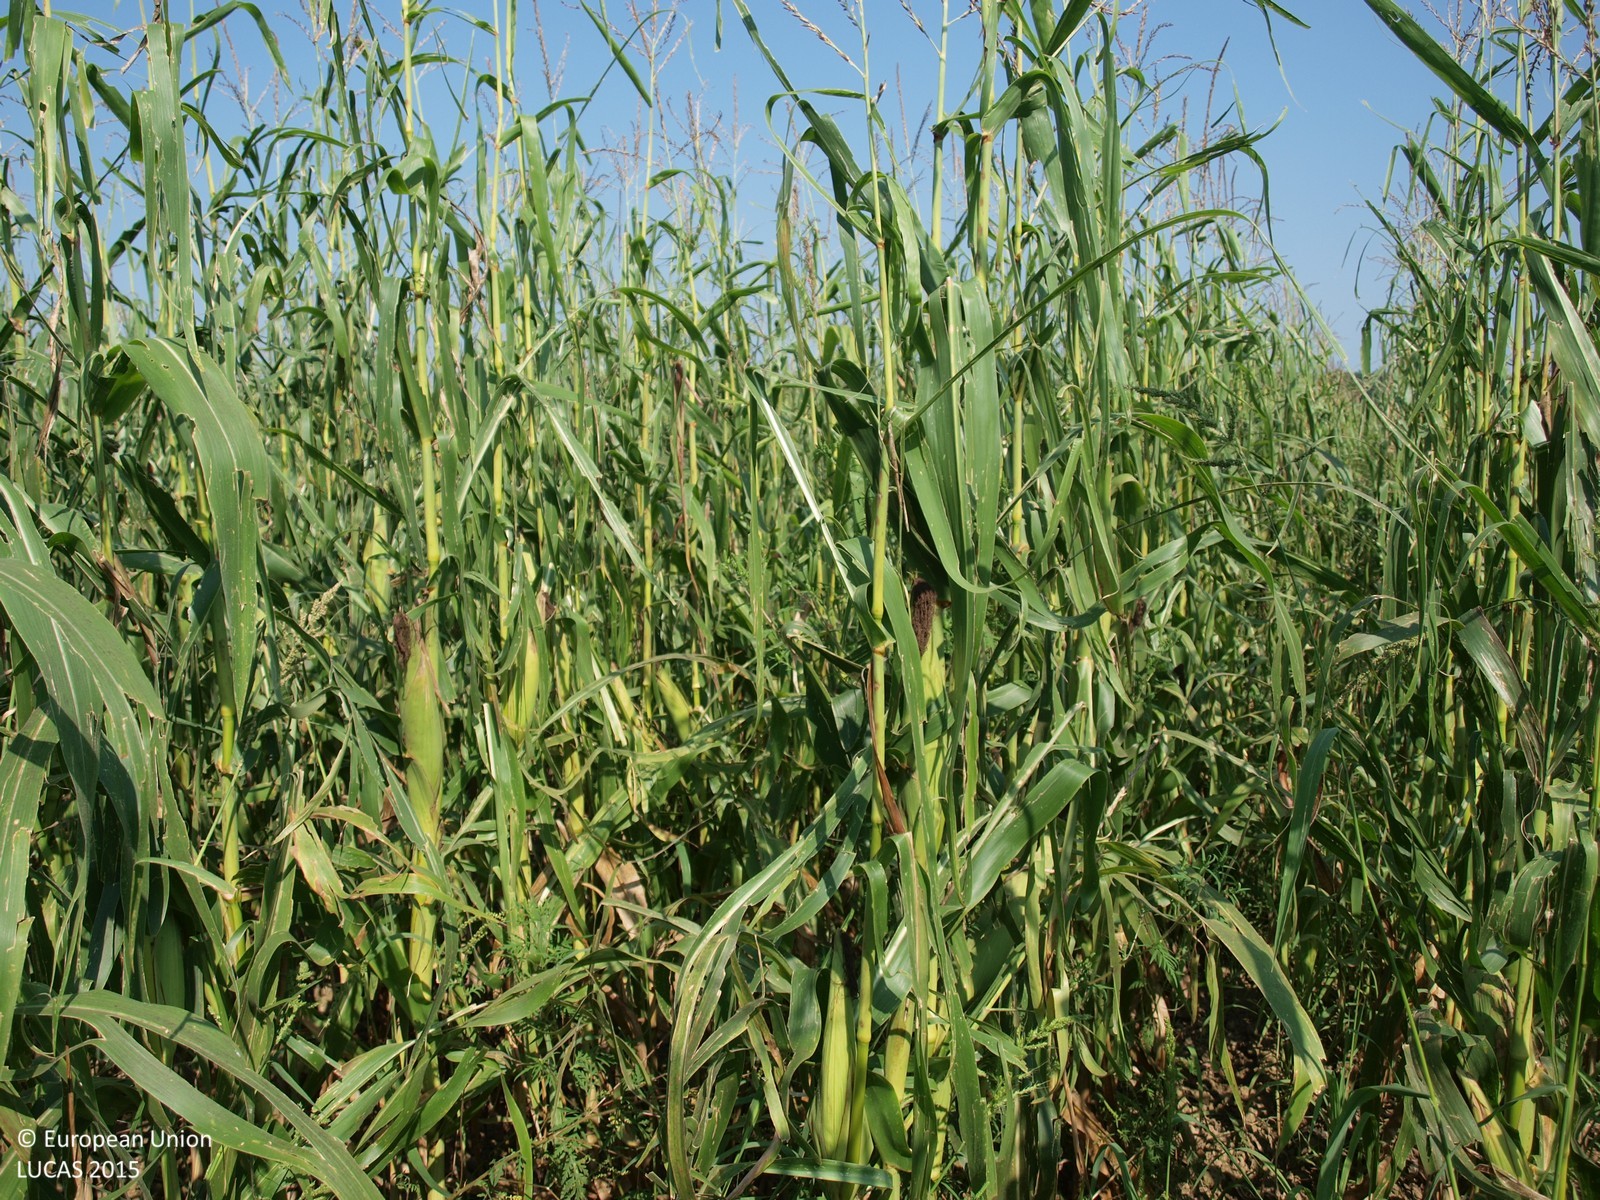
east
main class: Cropland
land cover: Maize
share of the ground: > 75 %
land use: Agriculture (excluding fallow land and kitchen gardens)
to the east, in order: Maize; Tracks; Maize; Grassland without tree/shrub cover; Abandoned hedges; Ditches and canals; Abandoned hedges; Maize
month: August
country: HR
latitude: 45.9067
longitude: 16.6903
